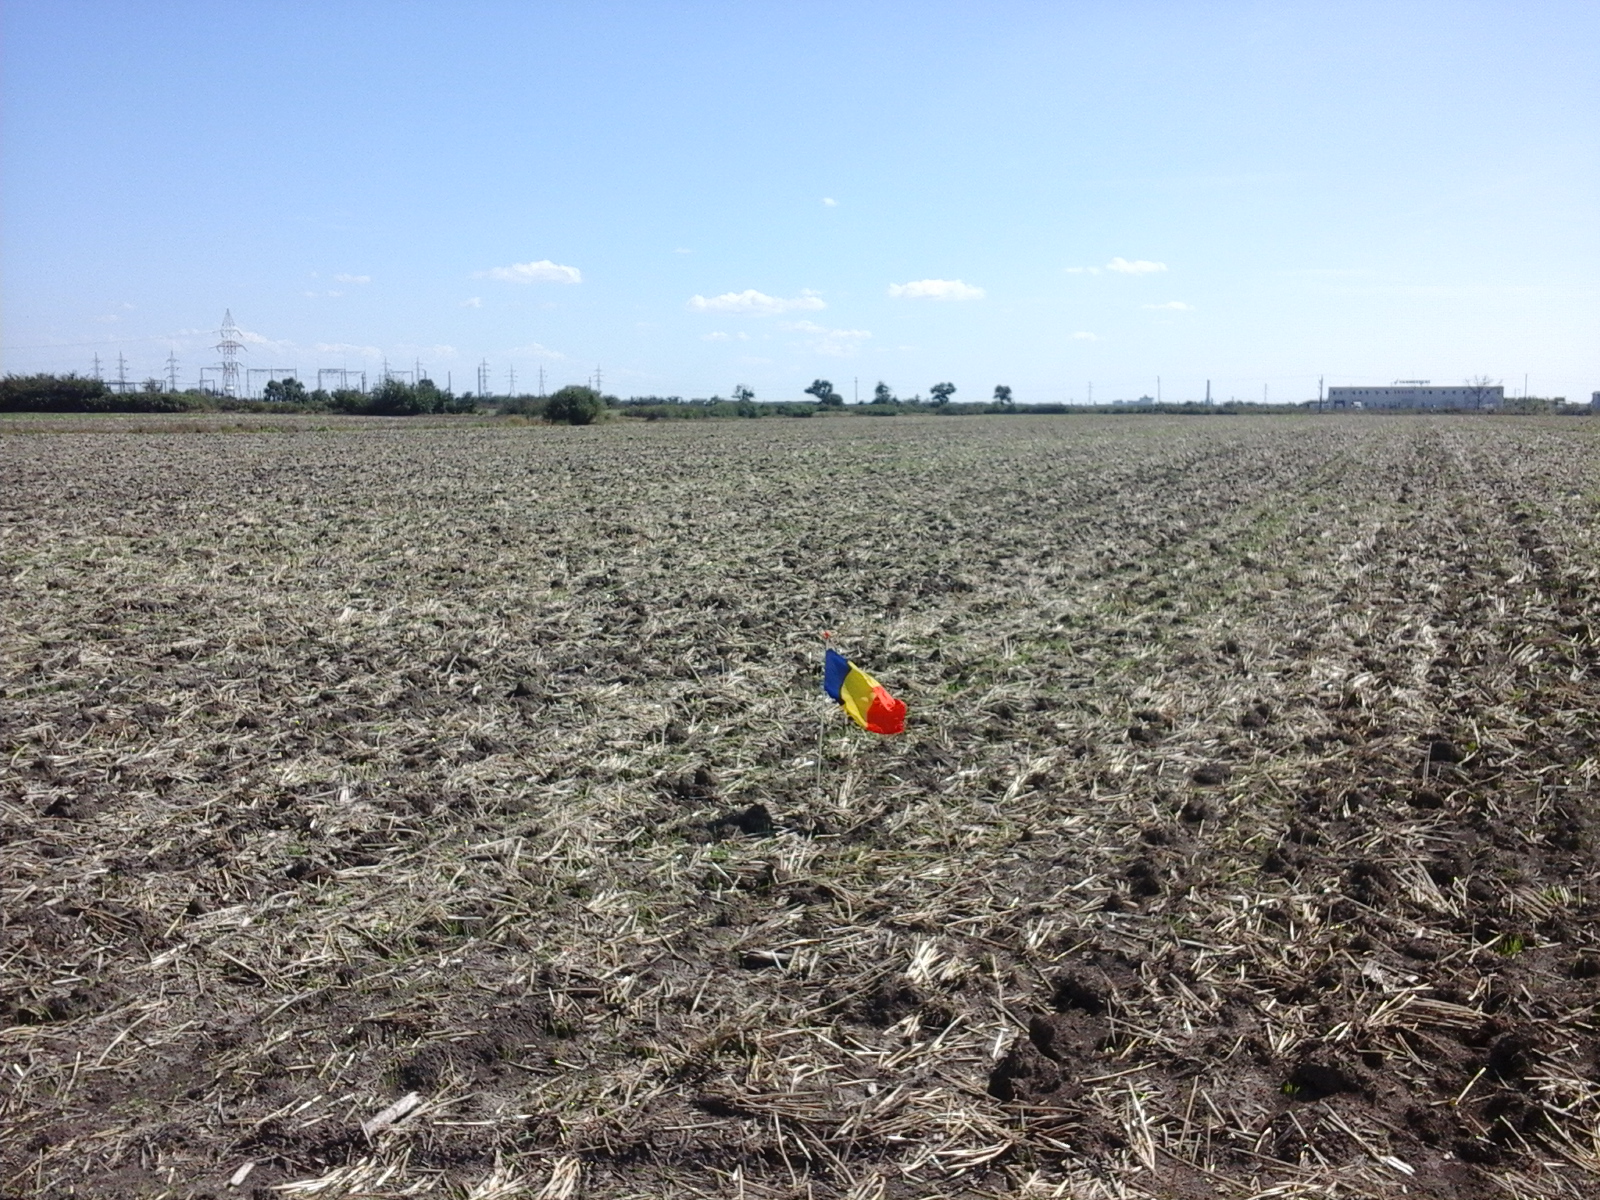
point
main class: Cropland
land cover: Common wheat
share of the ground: < 10 %
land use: Agriculture (excluding fallow land and kitchen gardens)
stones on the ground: < 10 %
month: August
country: RO
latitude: 45.7661
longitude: 21.1522
